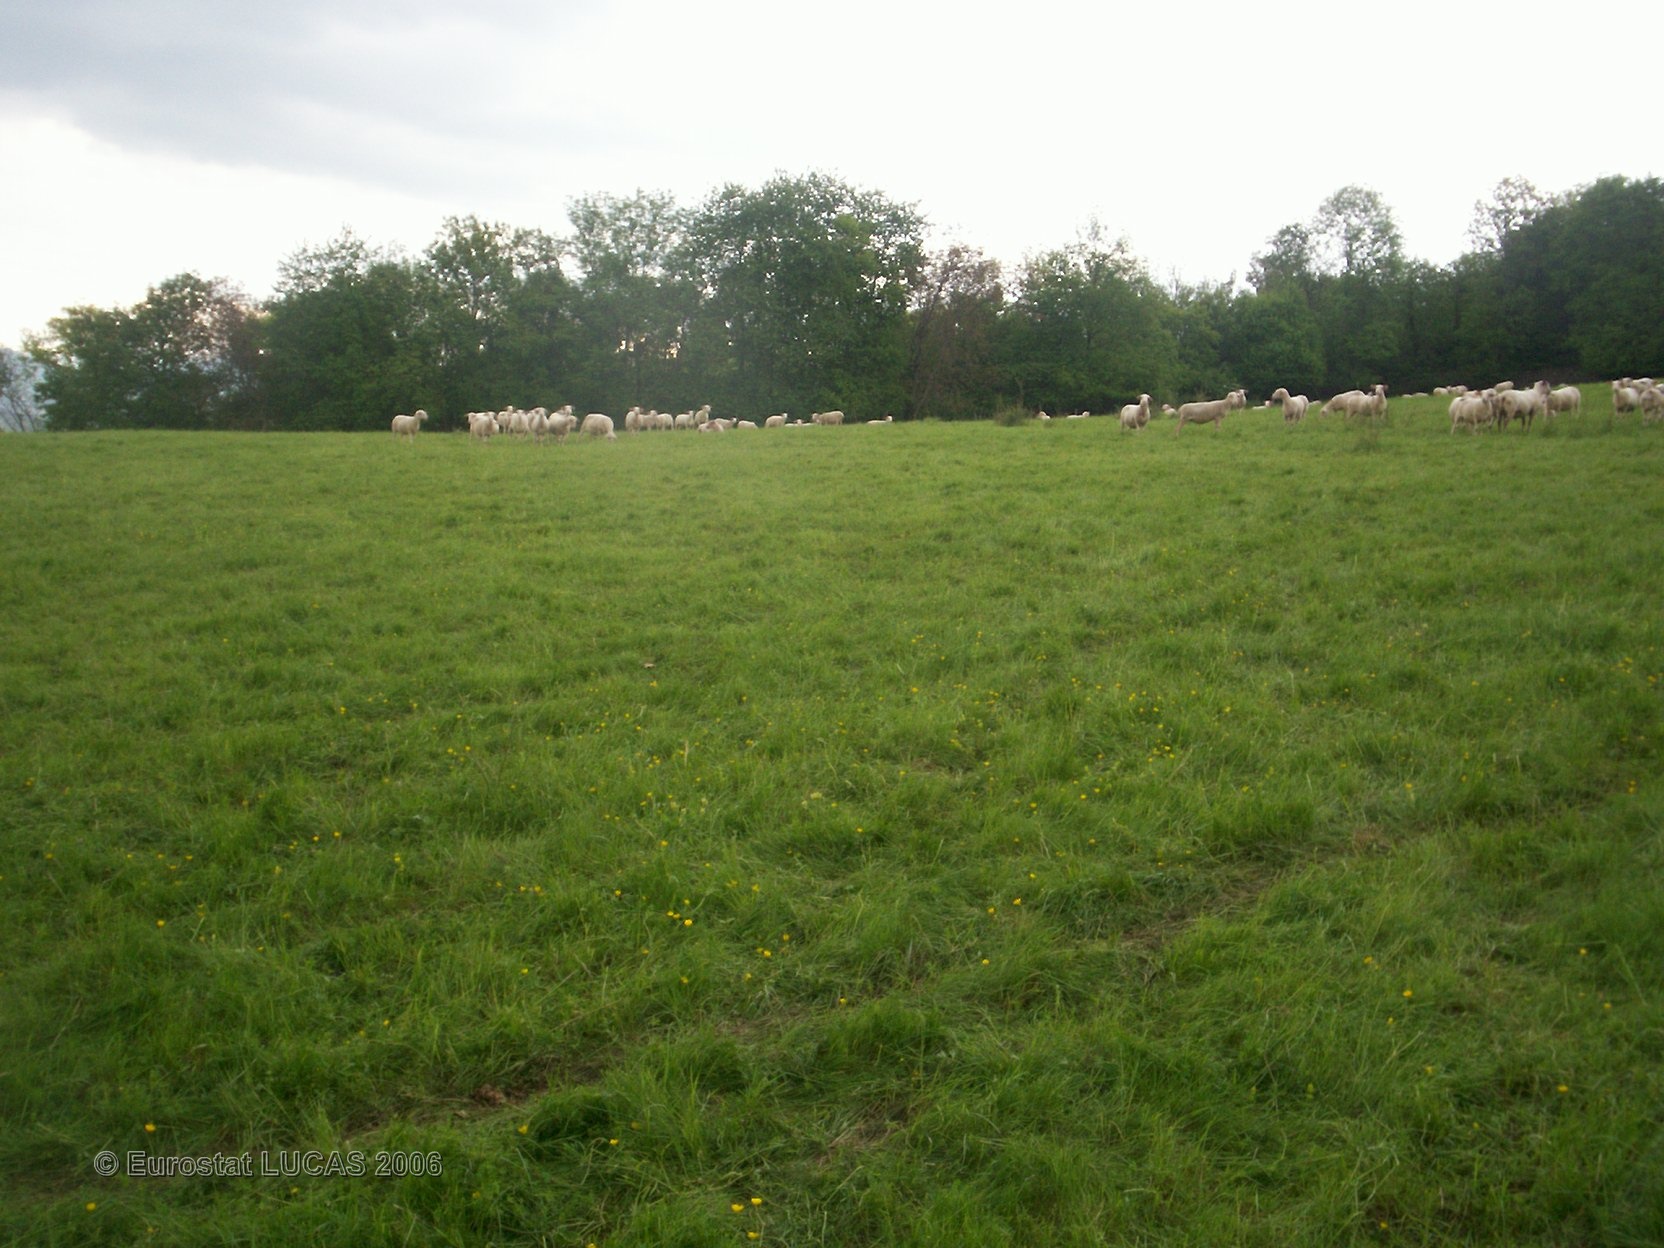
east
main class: Grassland
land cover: Grassland without tree/shrub cover
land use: Agriculture (excluding fallow land and kitchen gardens)
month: May
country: FR
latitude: 45.6588
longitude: 3.1084
